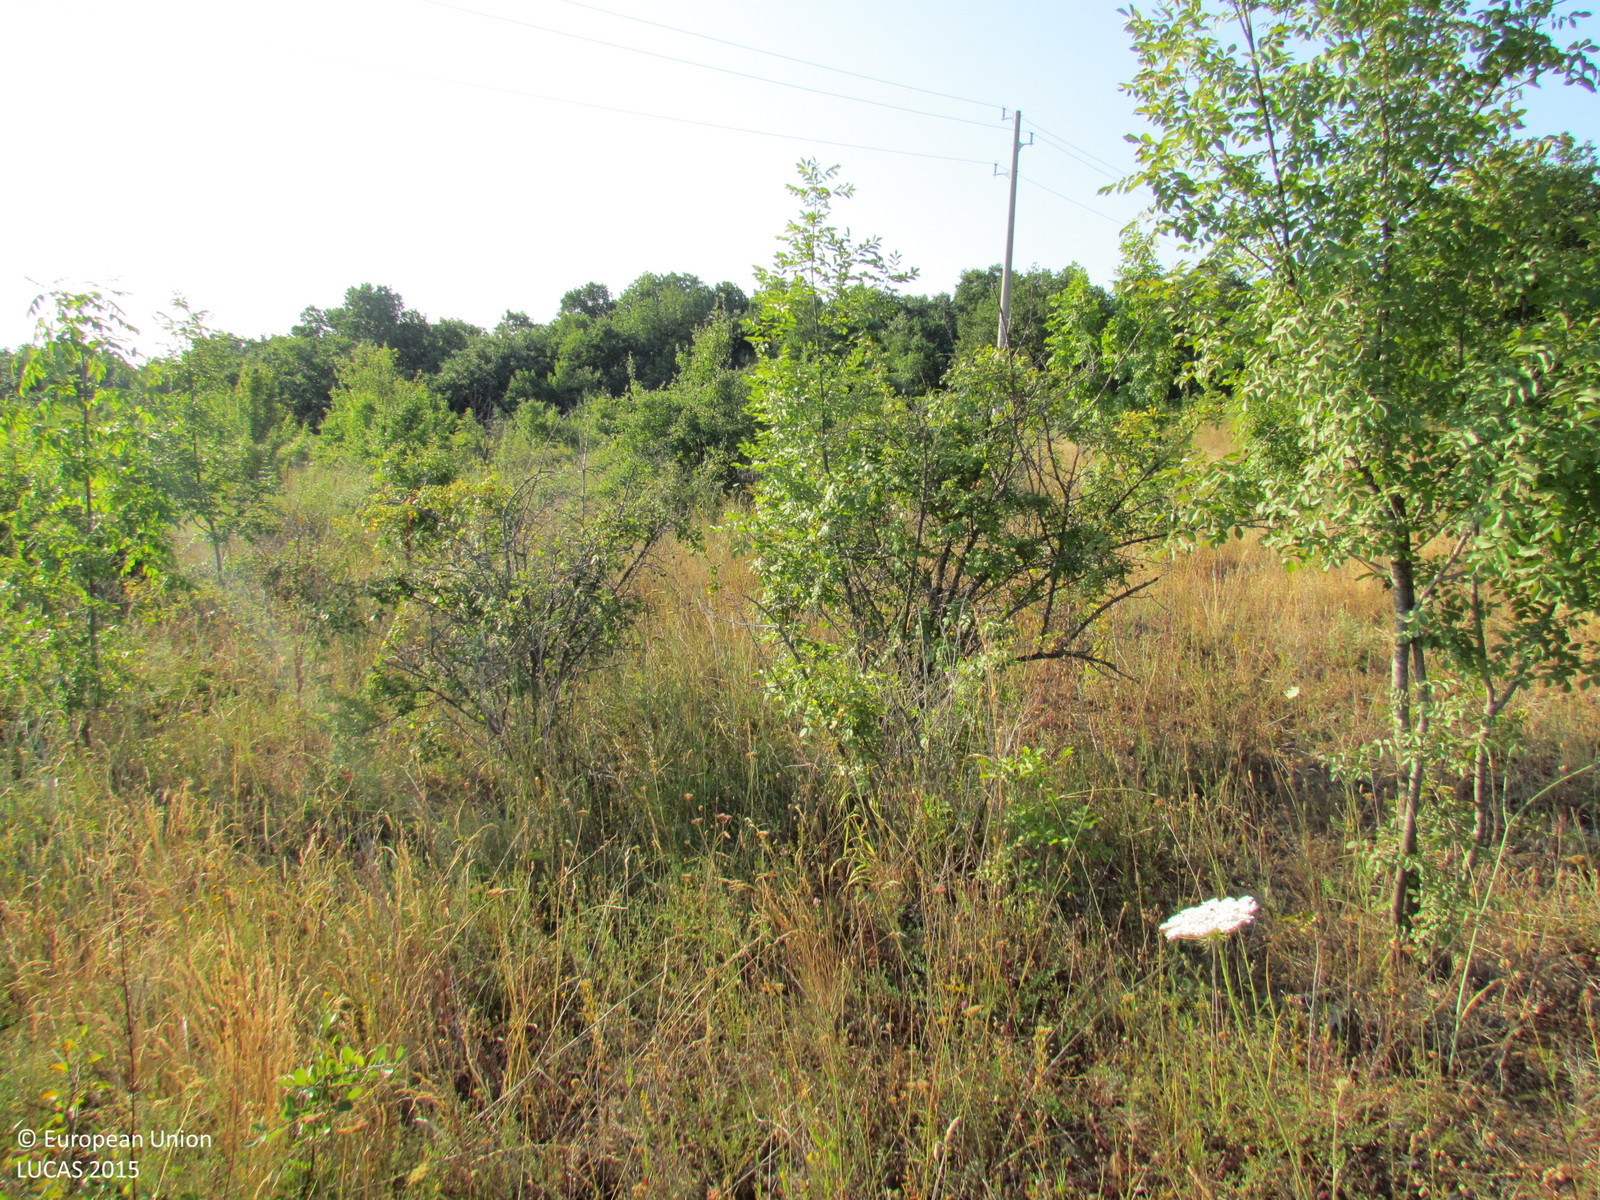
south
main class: Shrubland
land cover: Shrubland with sparse tree cover
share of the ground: 50 - 75 %
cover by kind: shrubs 55 %, herbaceous plants 40 %, broadleaved forest trees 5 %
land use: Semi-natural and natural areas not in use
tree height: < 5 m
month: July
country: BG
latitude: 42.7447
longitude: 27.8822
